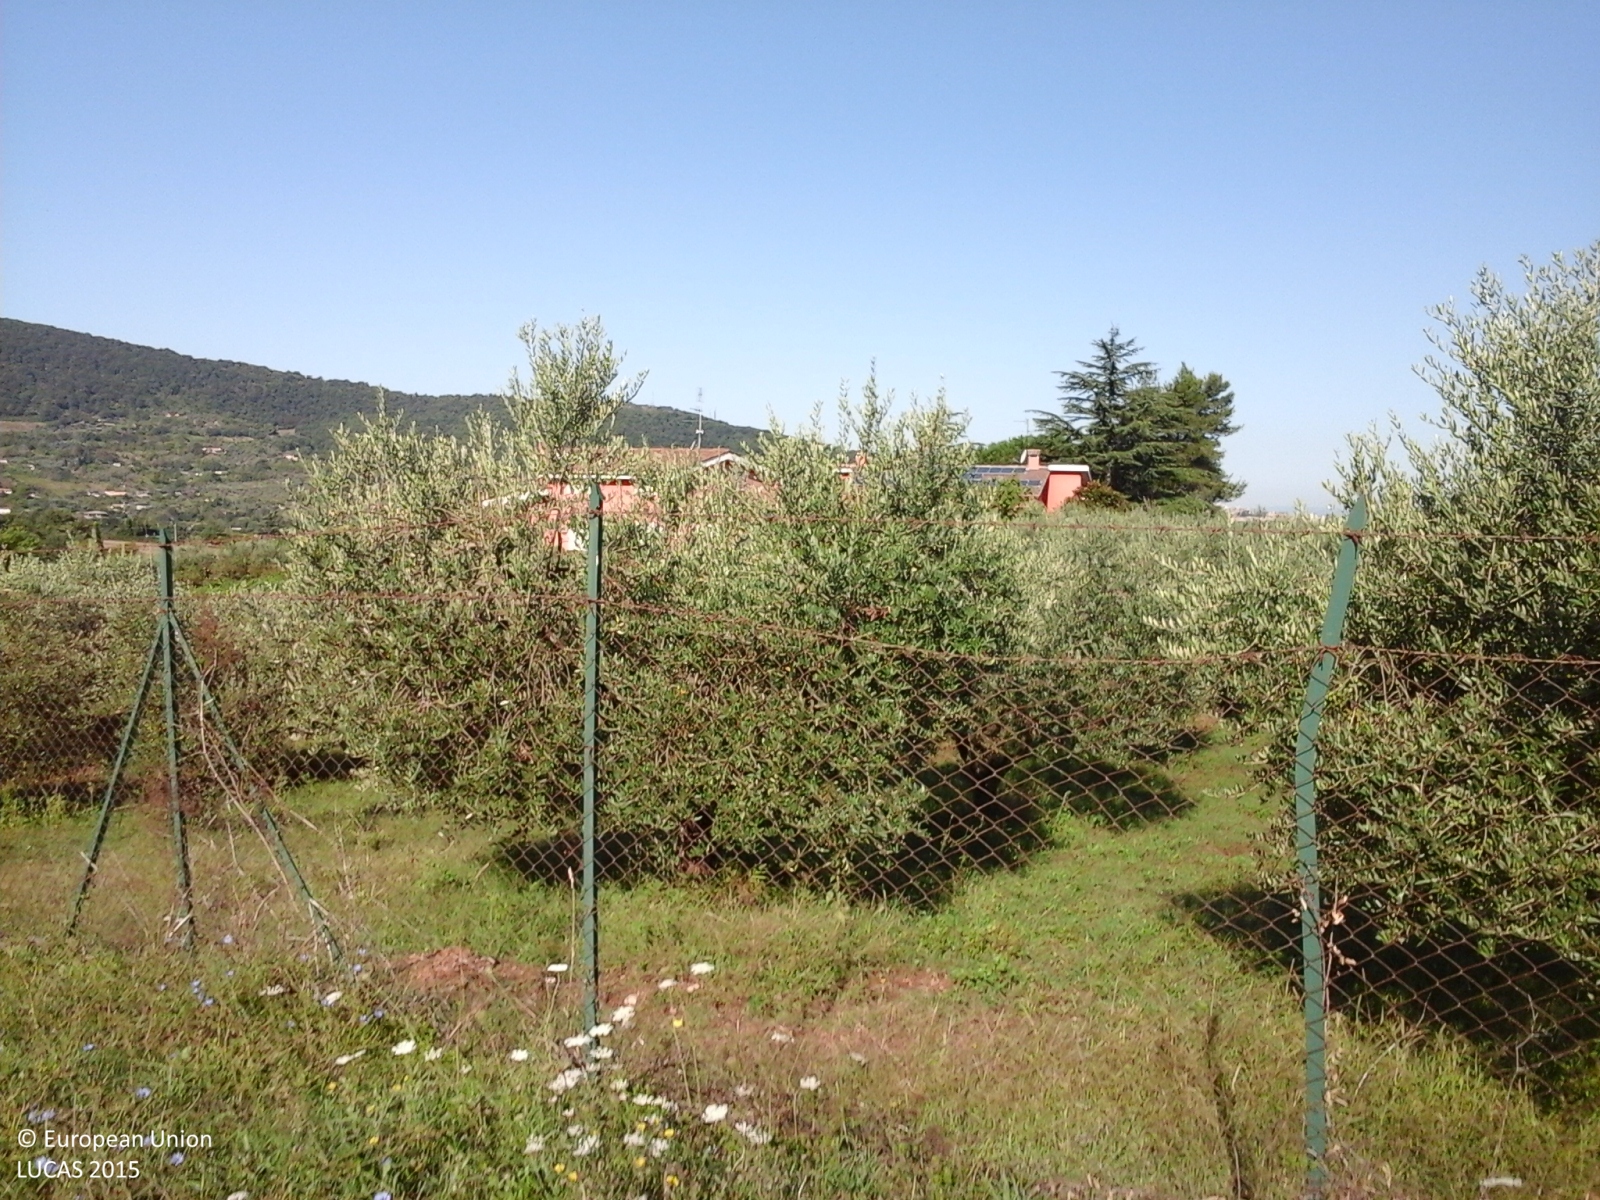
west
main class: Cropland
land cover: Olive groves
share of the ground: 25 - 50 %
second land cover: Grassland without tree/shrub cover
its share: > 75 %
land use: Agriculture (excluding fallow land and kitchen gardens)
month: August
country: IT
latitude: 41.9452
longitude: 12.8484
